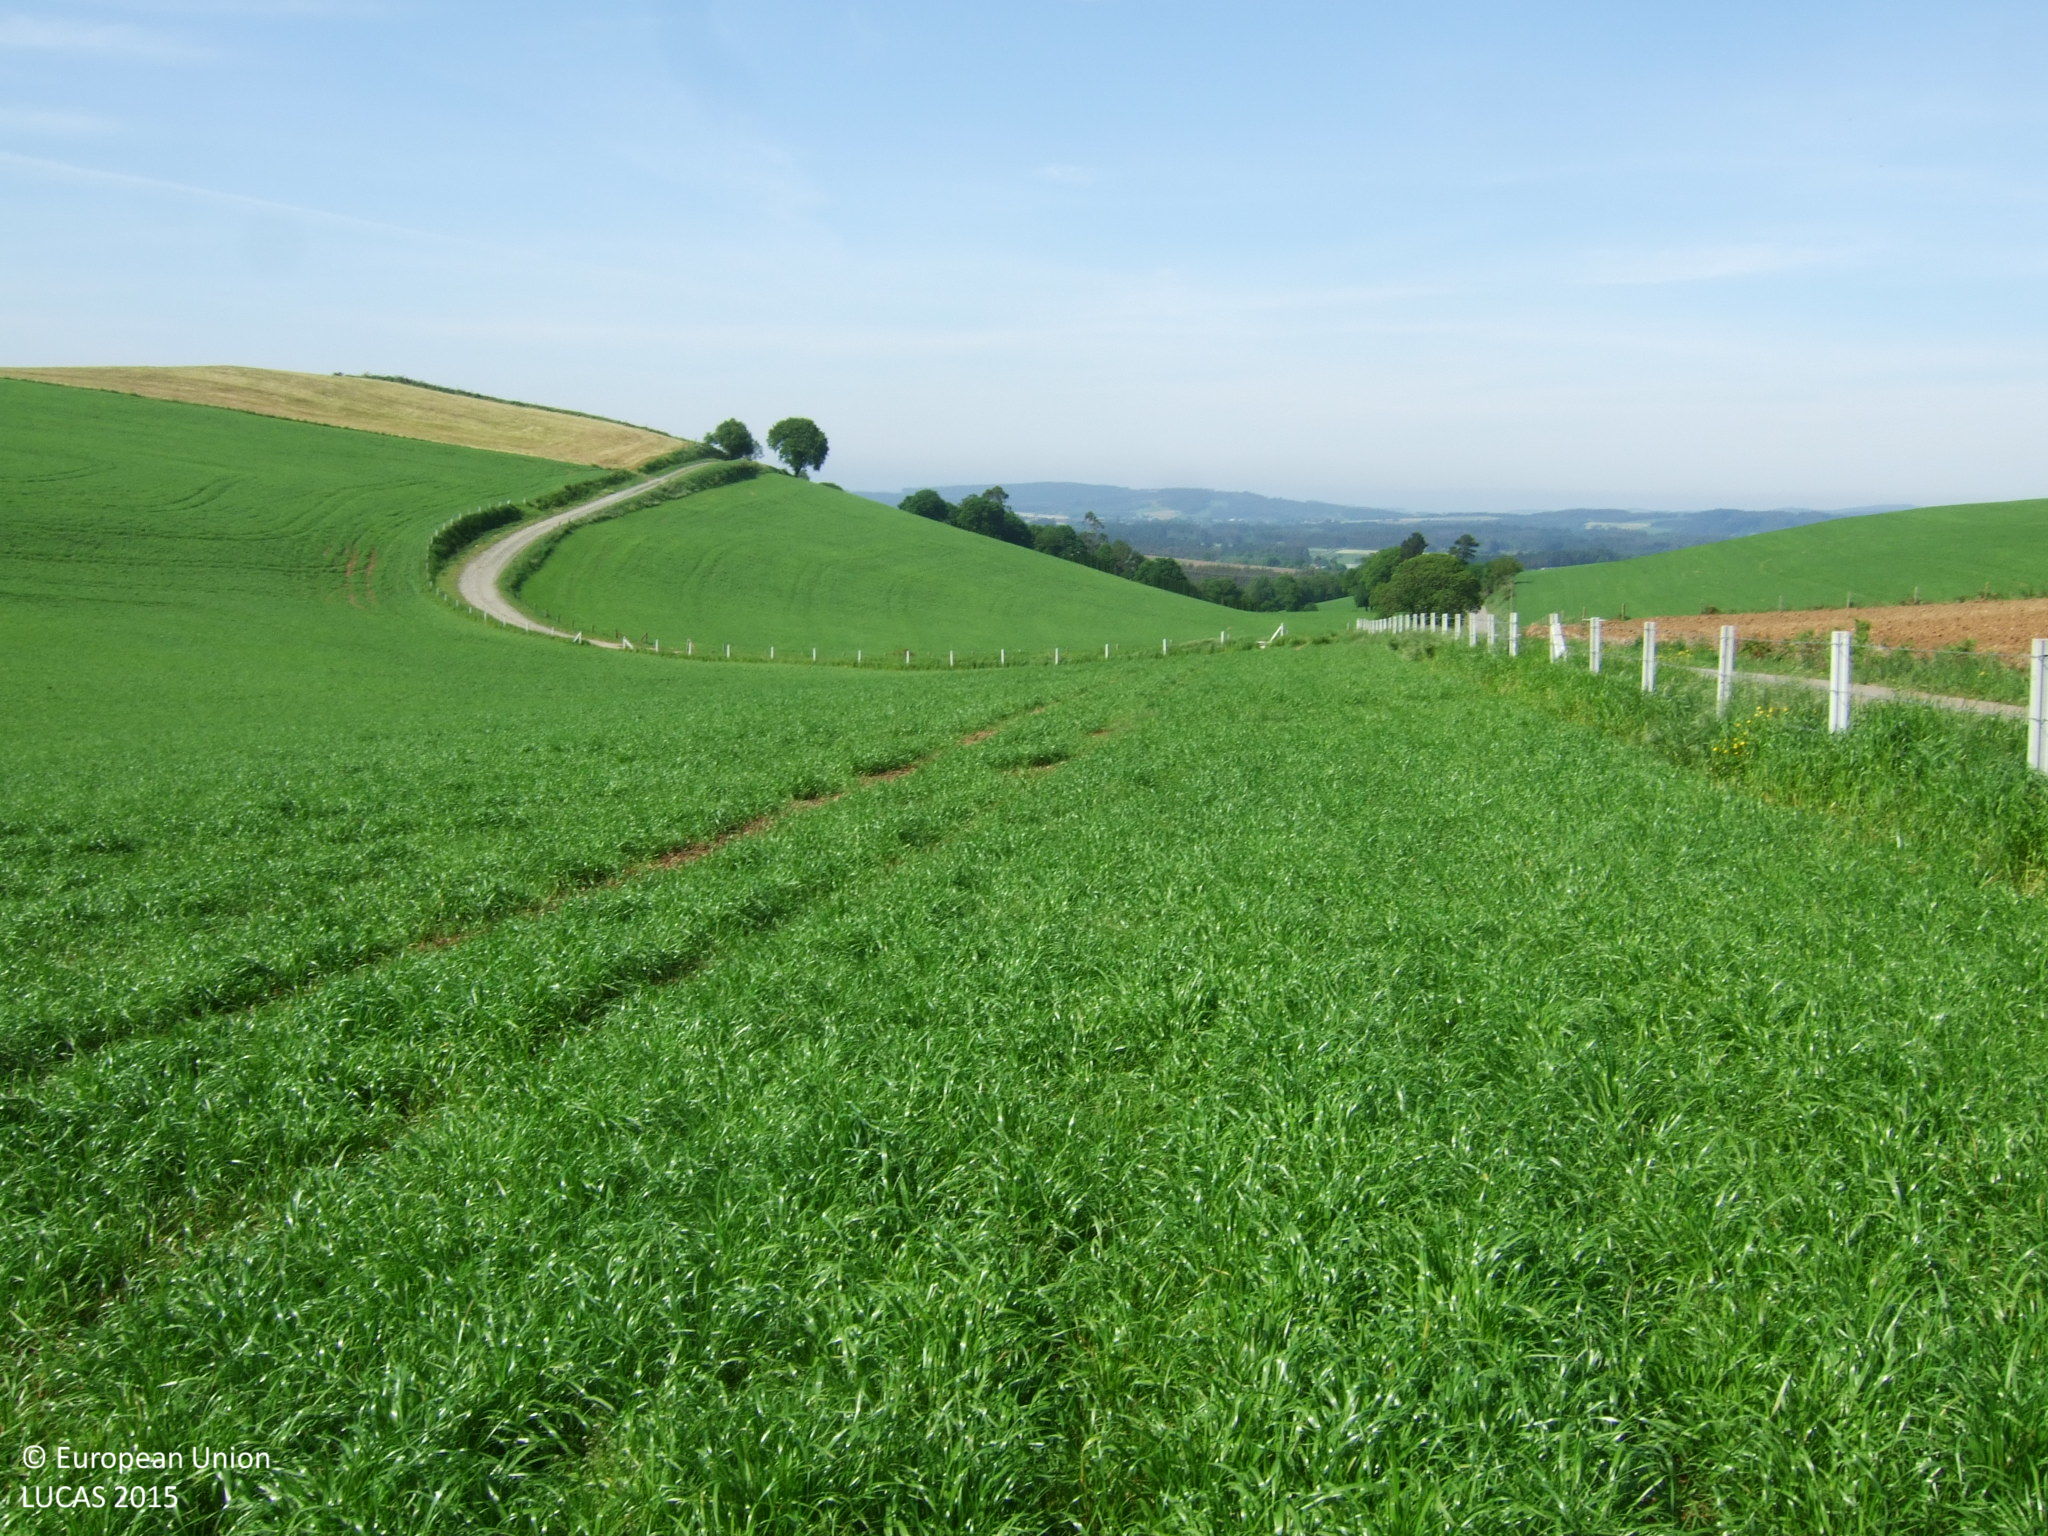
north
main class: Cropland
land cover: Temporary grasslands
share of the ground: > 75 %
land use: Agriculture (excluding fallow land and kitchen gardens)
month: May
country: ES
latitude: 43.1298
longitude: -7.3693
